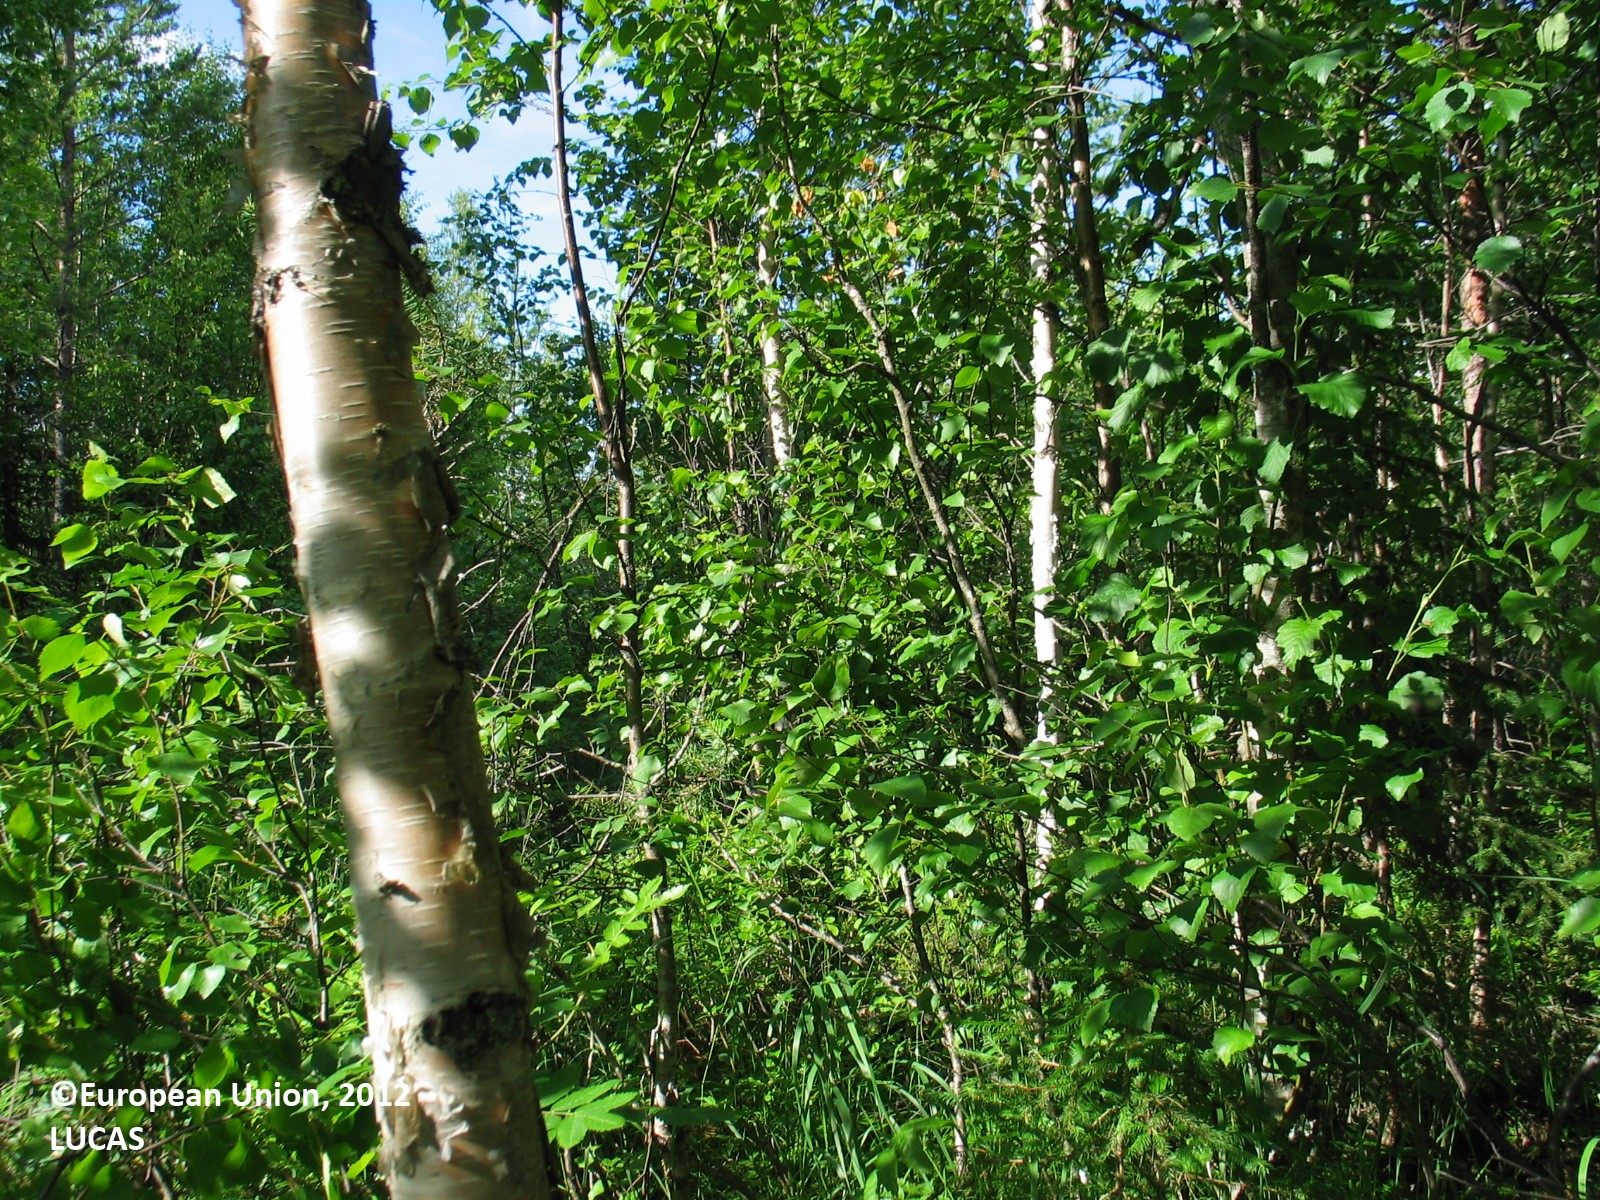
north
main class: Woodland
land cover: Broadleaved woodland
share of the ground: 50 - 75 %
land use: Forestry
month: July
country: FI
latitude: 65.9410
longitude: 25.1217
